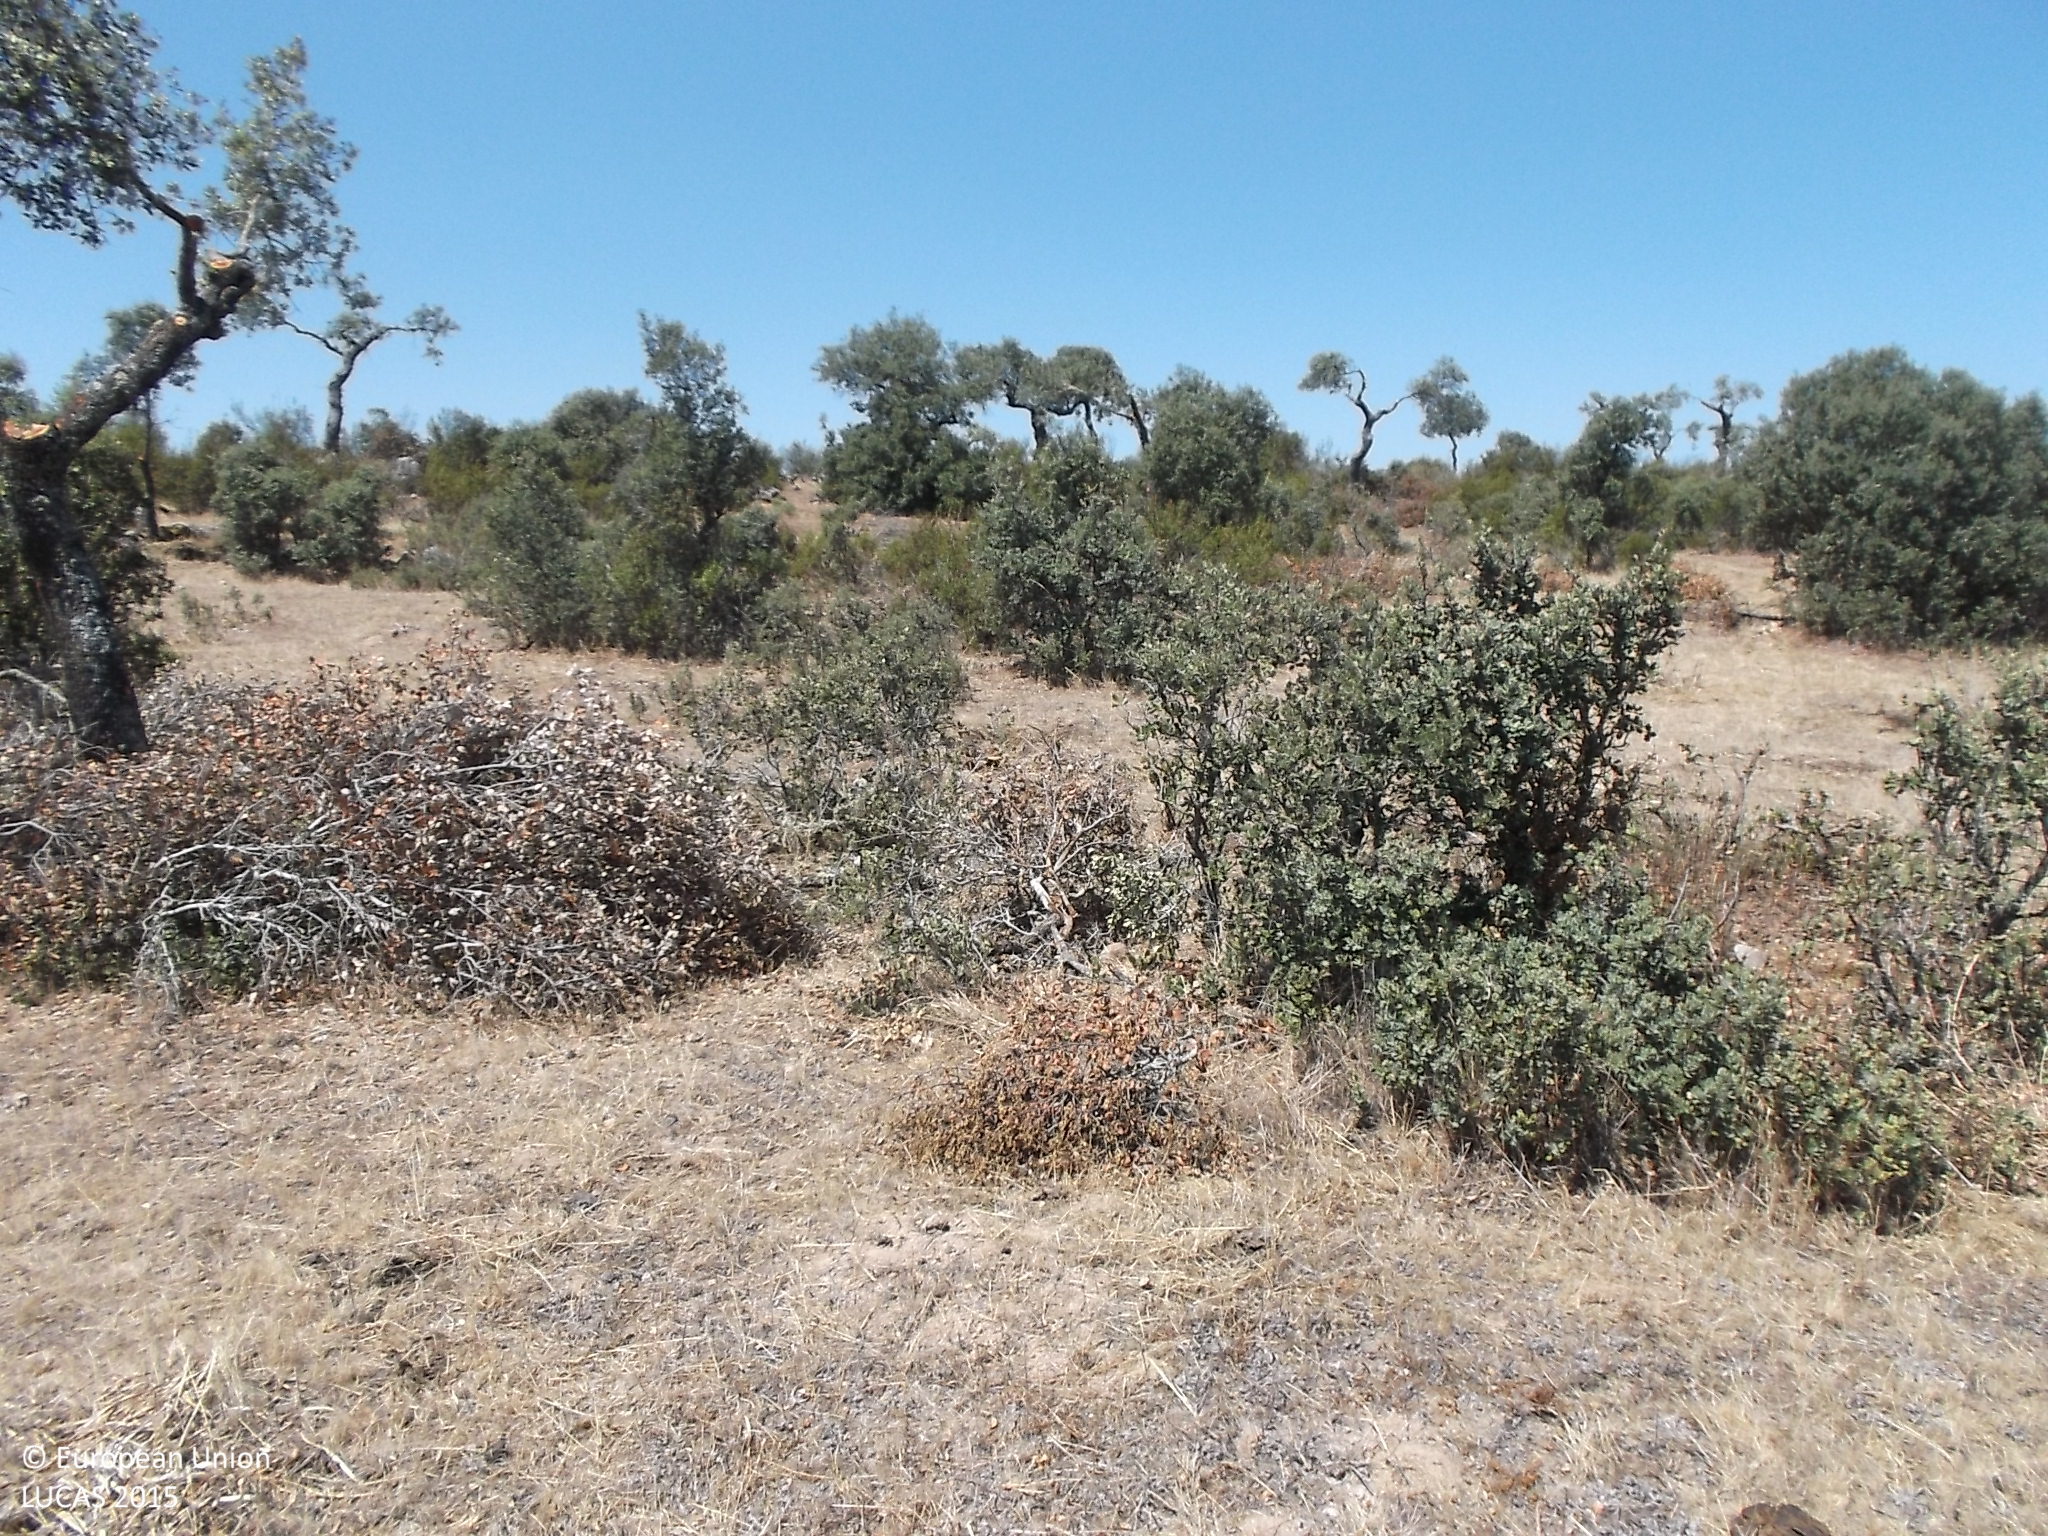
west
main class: Woodland
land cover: Broadleaved woodland
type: broadleaved evergreen forest
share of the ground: 10 - 25 %
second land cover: Grassland without tree/shrub cover
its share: > 75 %
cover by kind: herbaceous plants 80 %, broadleaved forest trees 20 %
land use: Forestry
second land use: Agriculture (excluding fallow land and kitchen gardens)
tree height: < 5 m
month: July
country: ES
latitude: 41.3456
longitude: -5.8255
